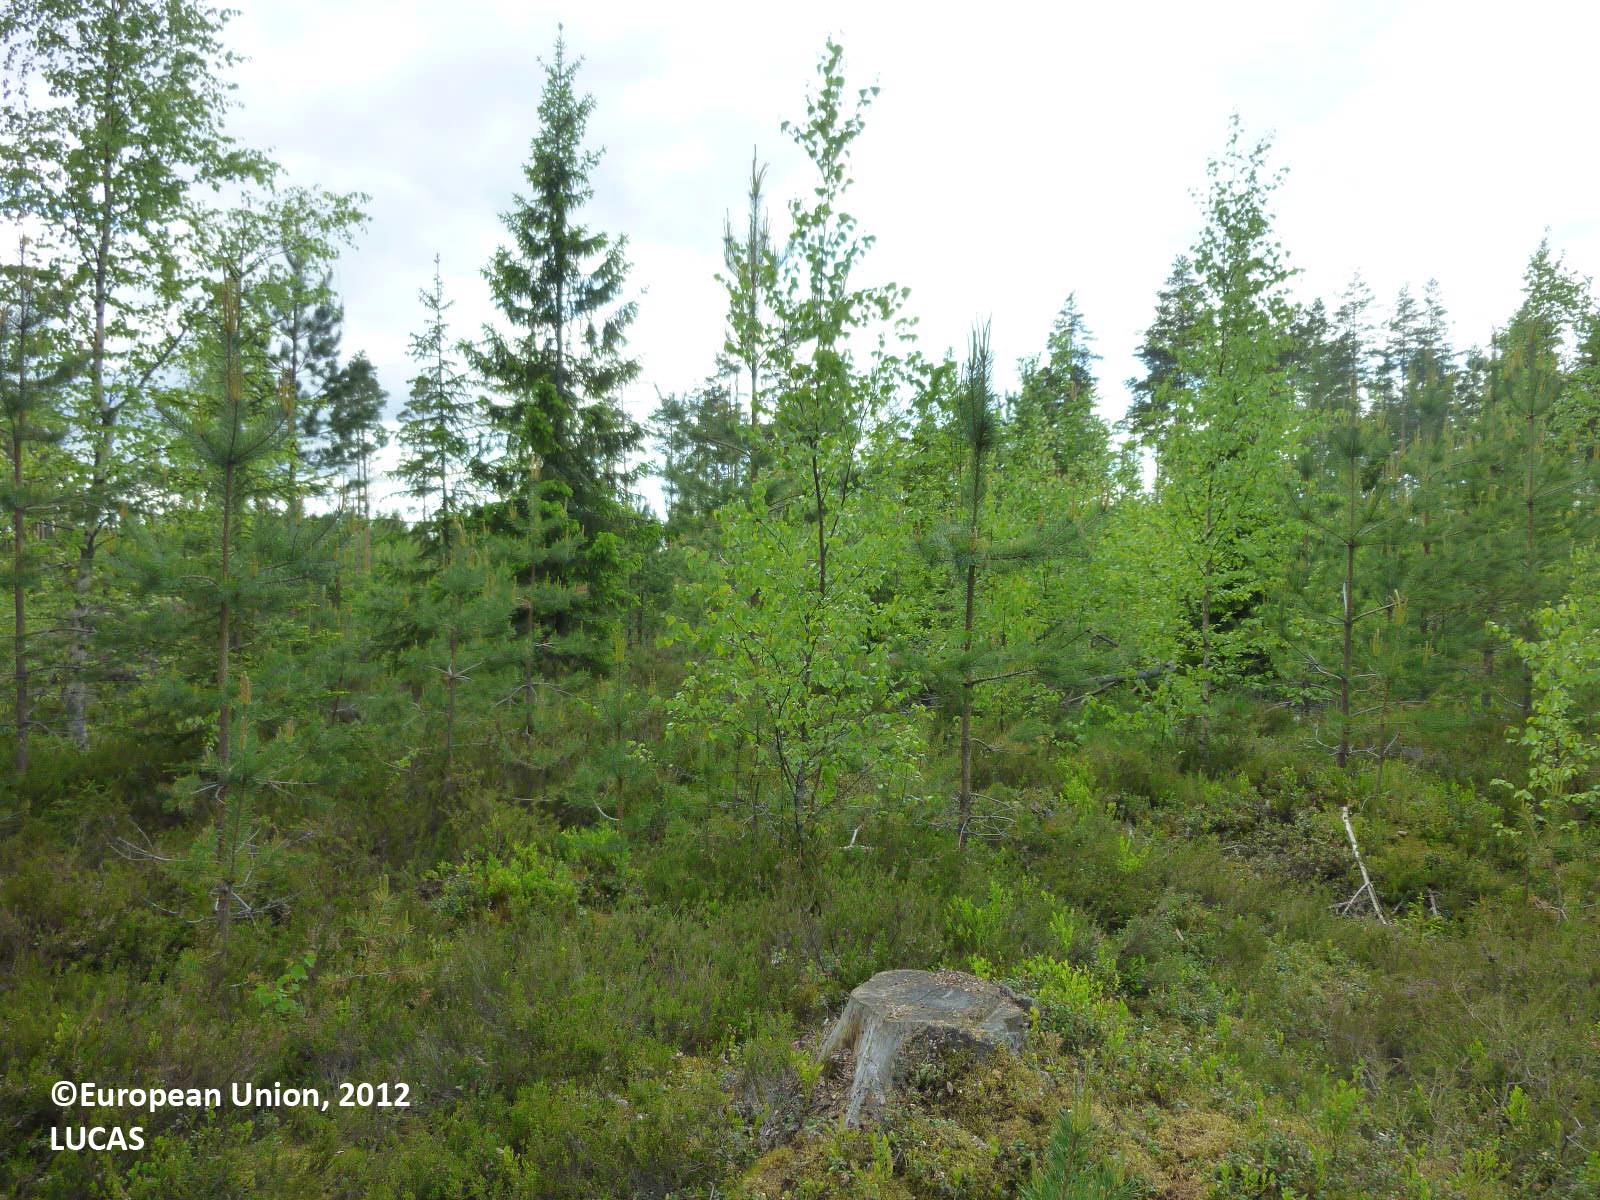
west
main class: Woodland
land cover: Pine dominated coniferous woodland
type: boreal forest
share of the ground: 25 - 50 %
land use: Forestry
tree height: > 5 m
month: June
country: FI
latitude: 60.5850
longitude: 22.7597
